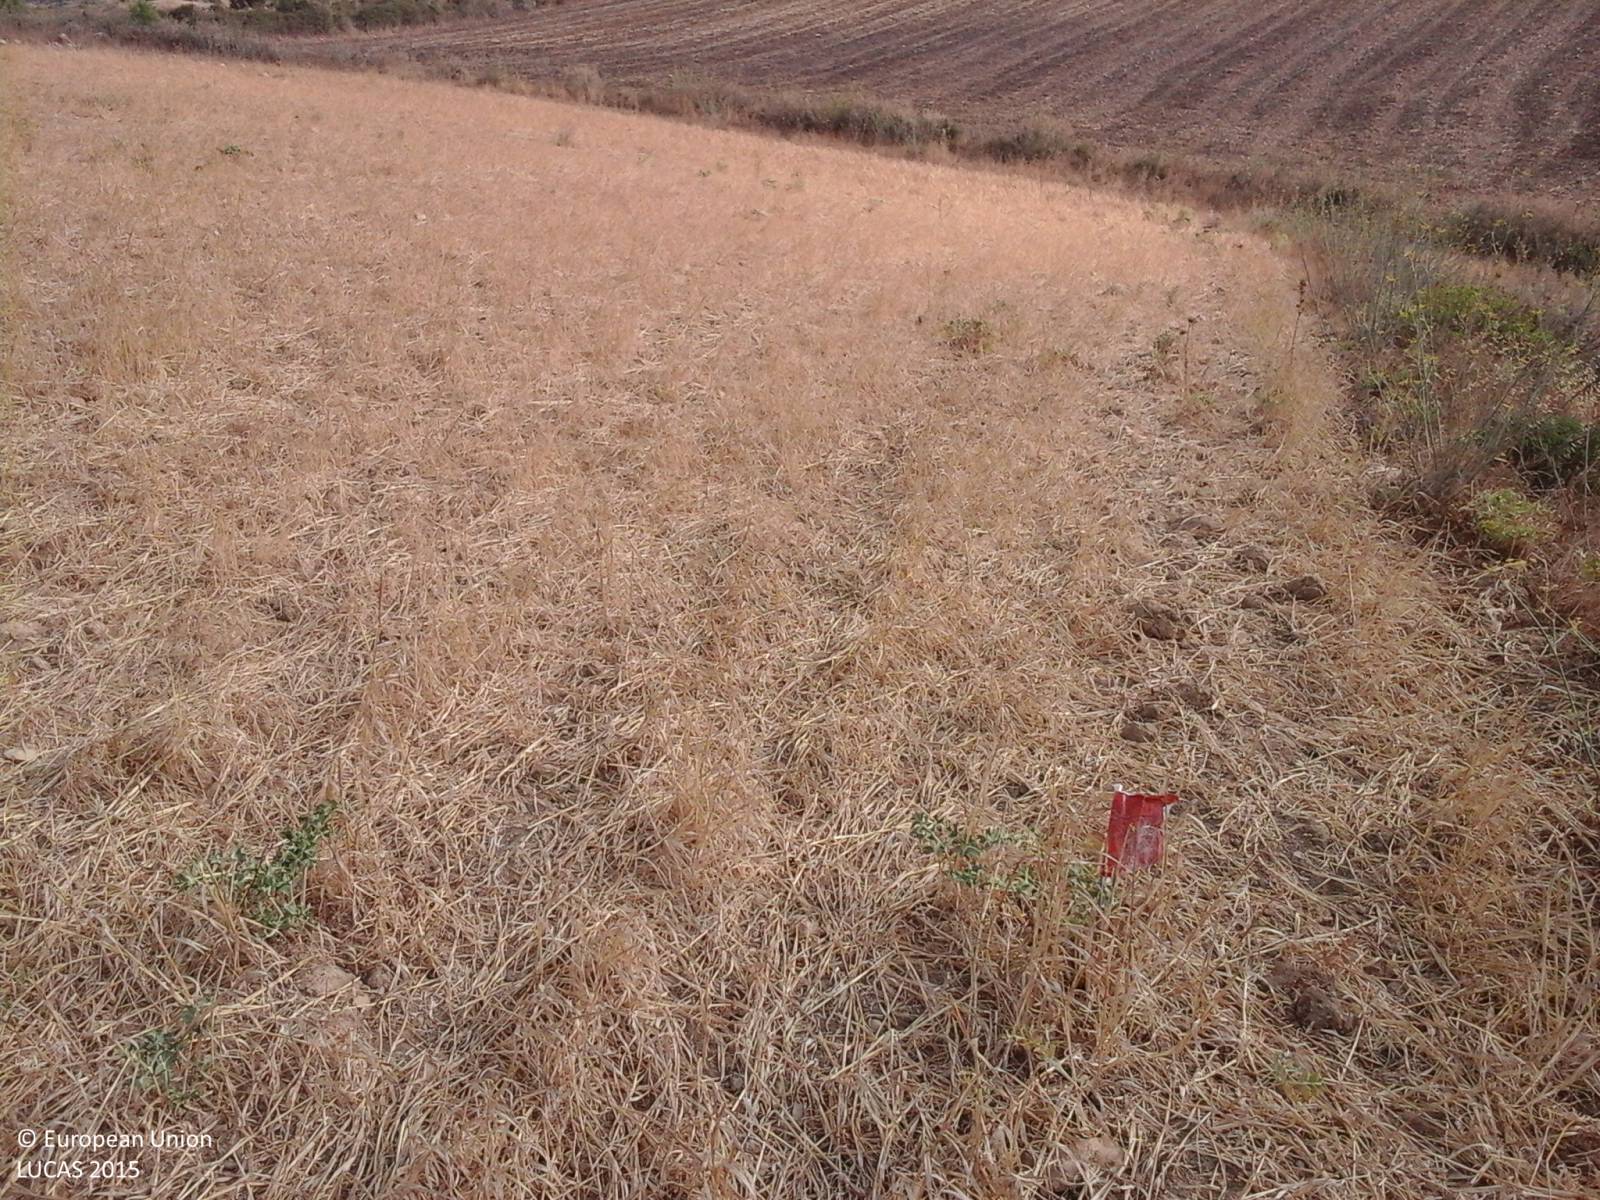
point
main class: Cropland
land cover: Mixed cereals for fodder
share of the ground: > 75 %
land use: Agriculture (excluding fallow land and kitchen gardens)
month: July
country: IT
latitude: 39.6089
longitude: 8.8768
